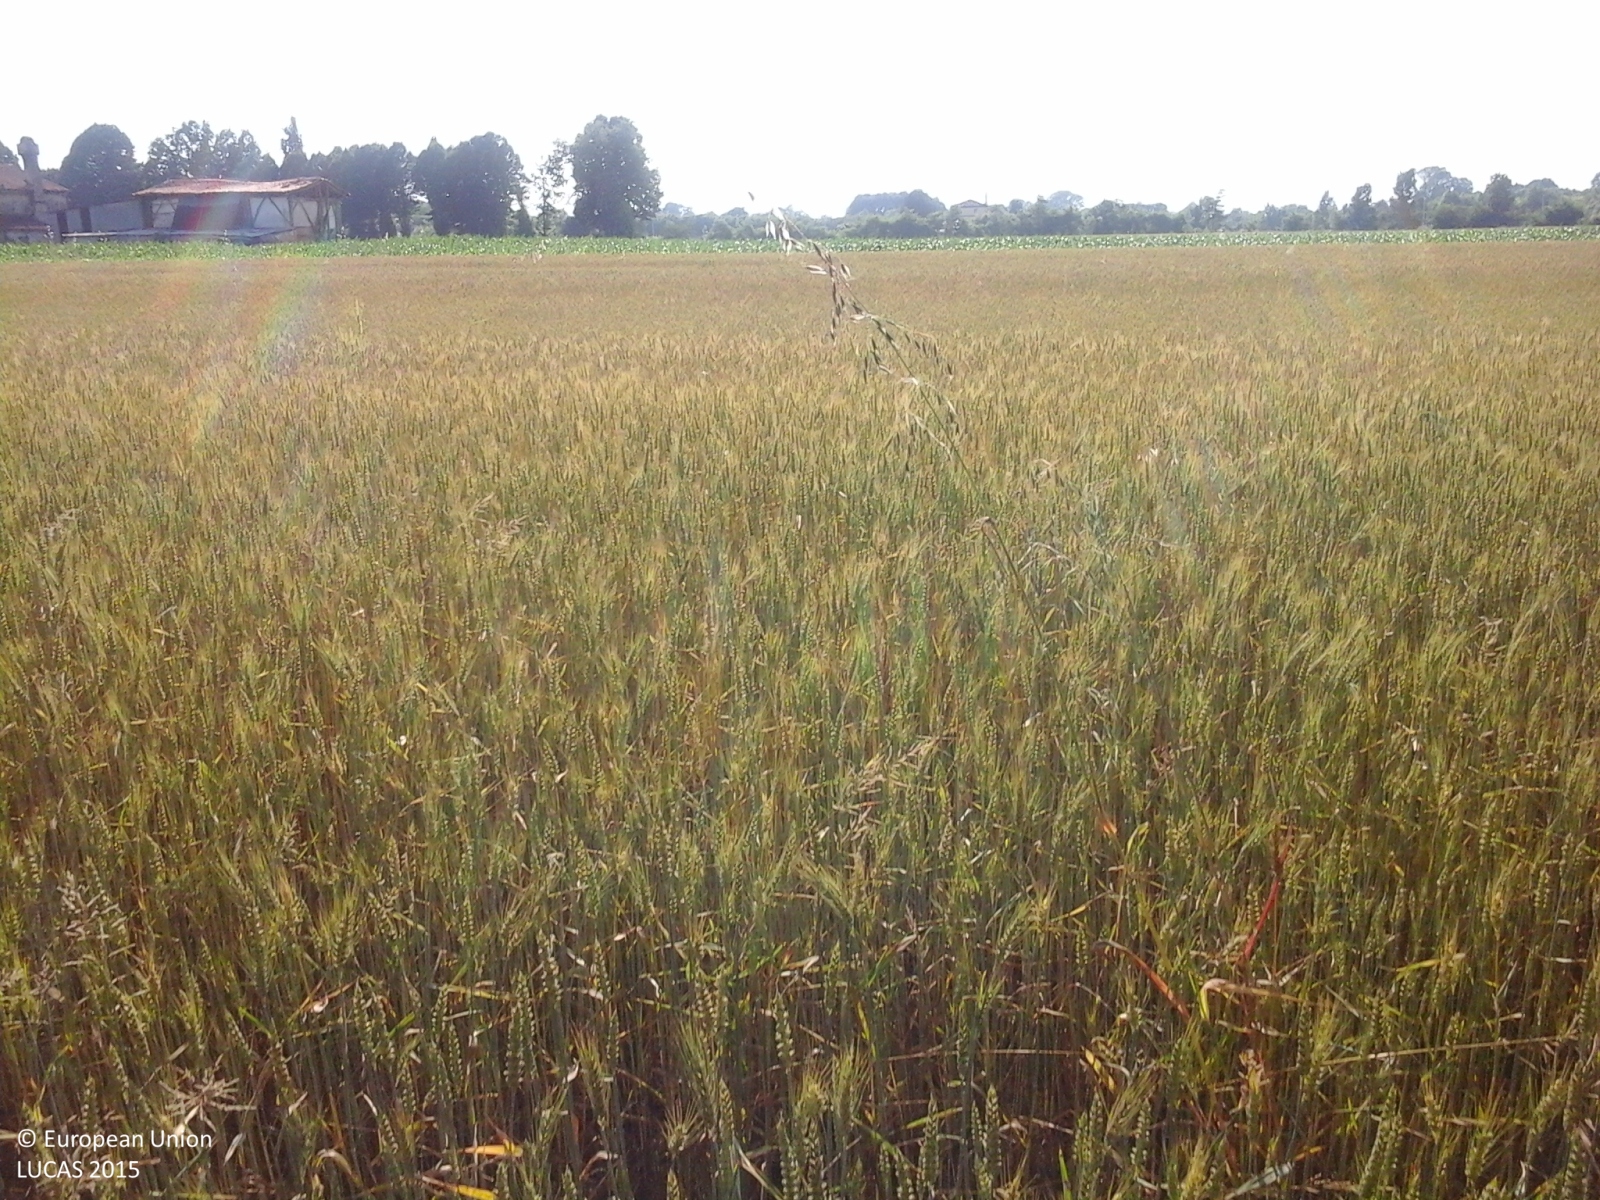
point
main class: Cropland
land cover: Common wheat
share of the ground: > 75 %
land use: Agriculture (excluding fallow land and kitchen gardens)
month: June
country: IT
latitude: 45.6052
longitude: 12.3172
